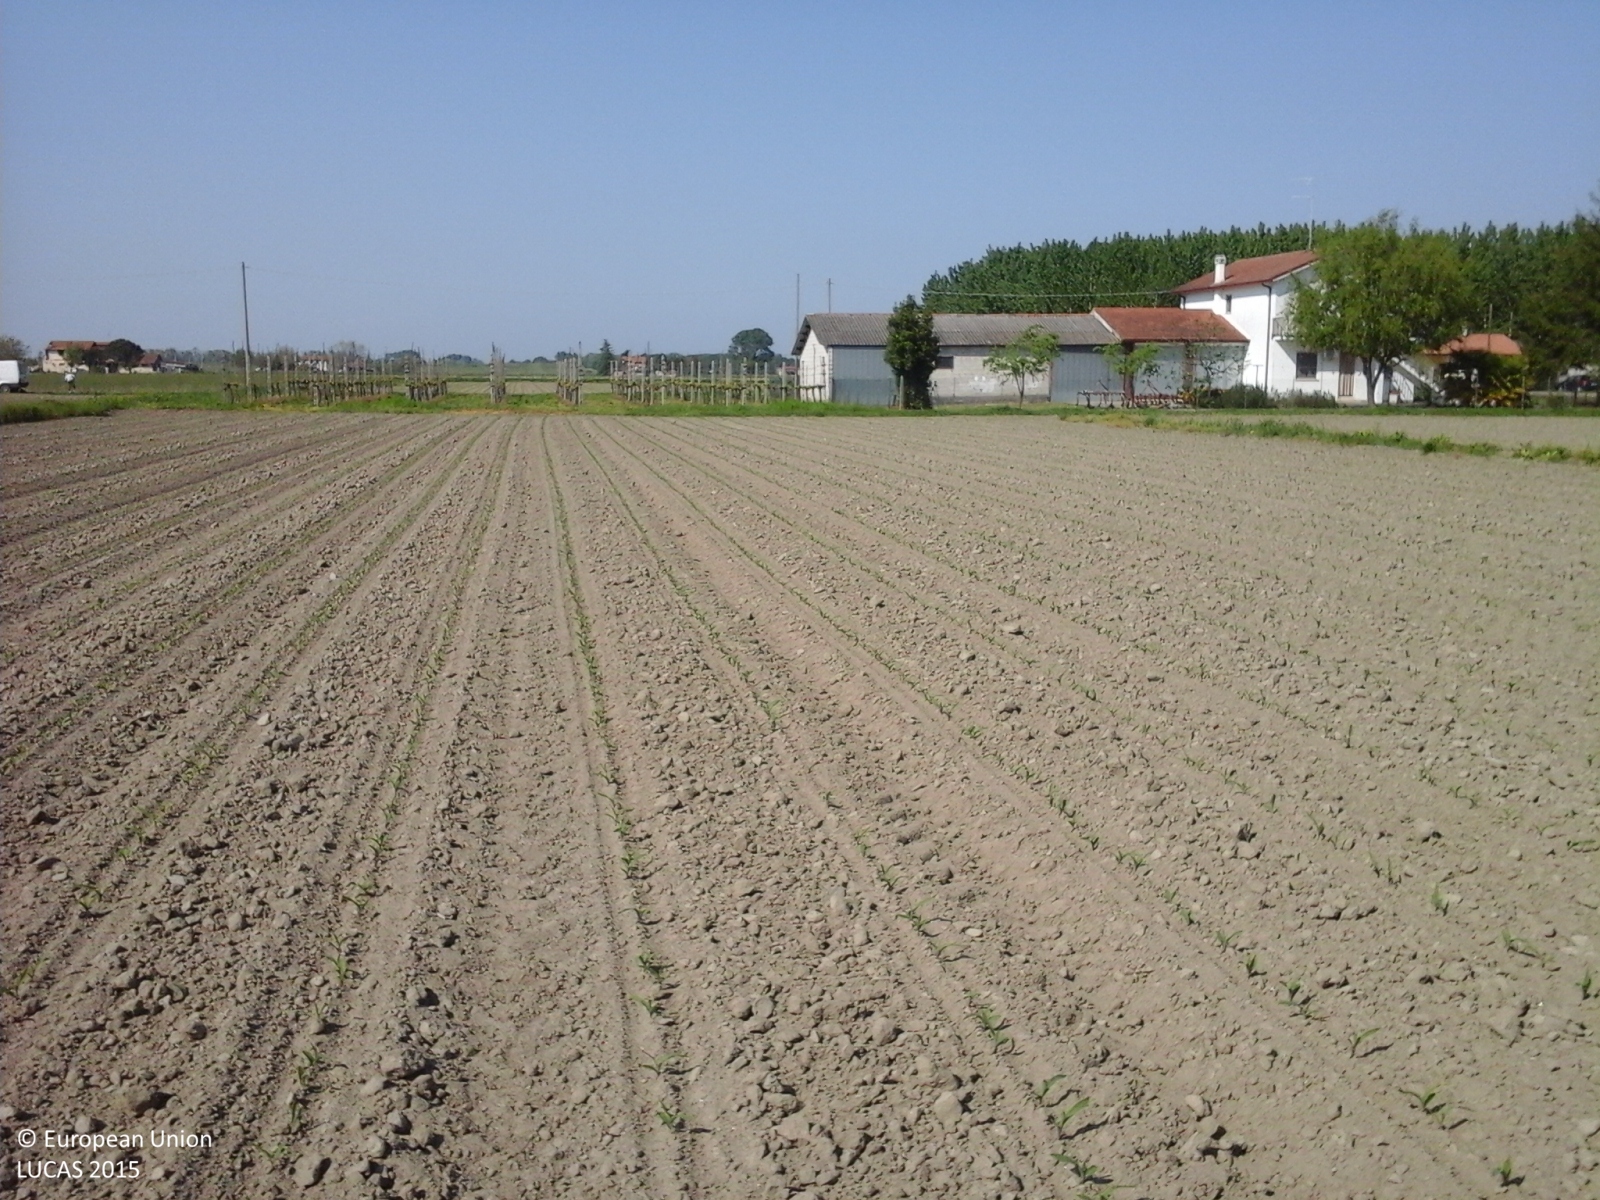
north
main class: Cropland
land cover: Maize
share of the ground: < 10 %
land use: Agriculture (excluding fallow land and kitchen gardens)
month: April
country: IT
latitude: 44.9212
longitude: 12.2635
